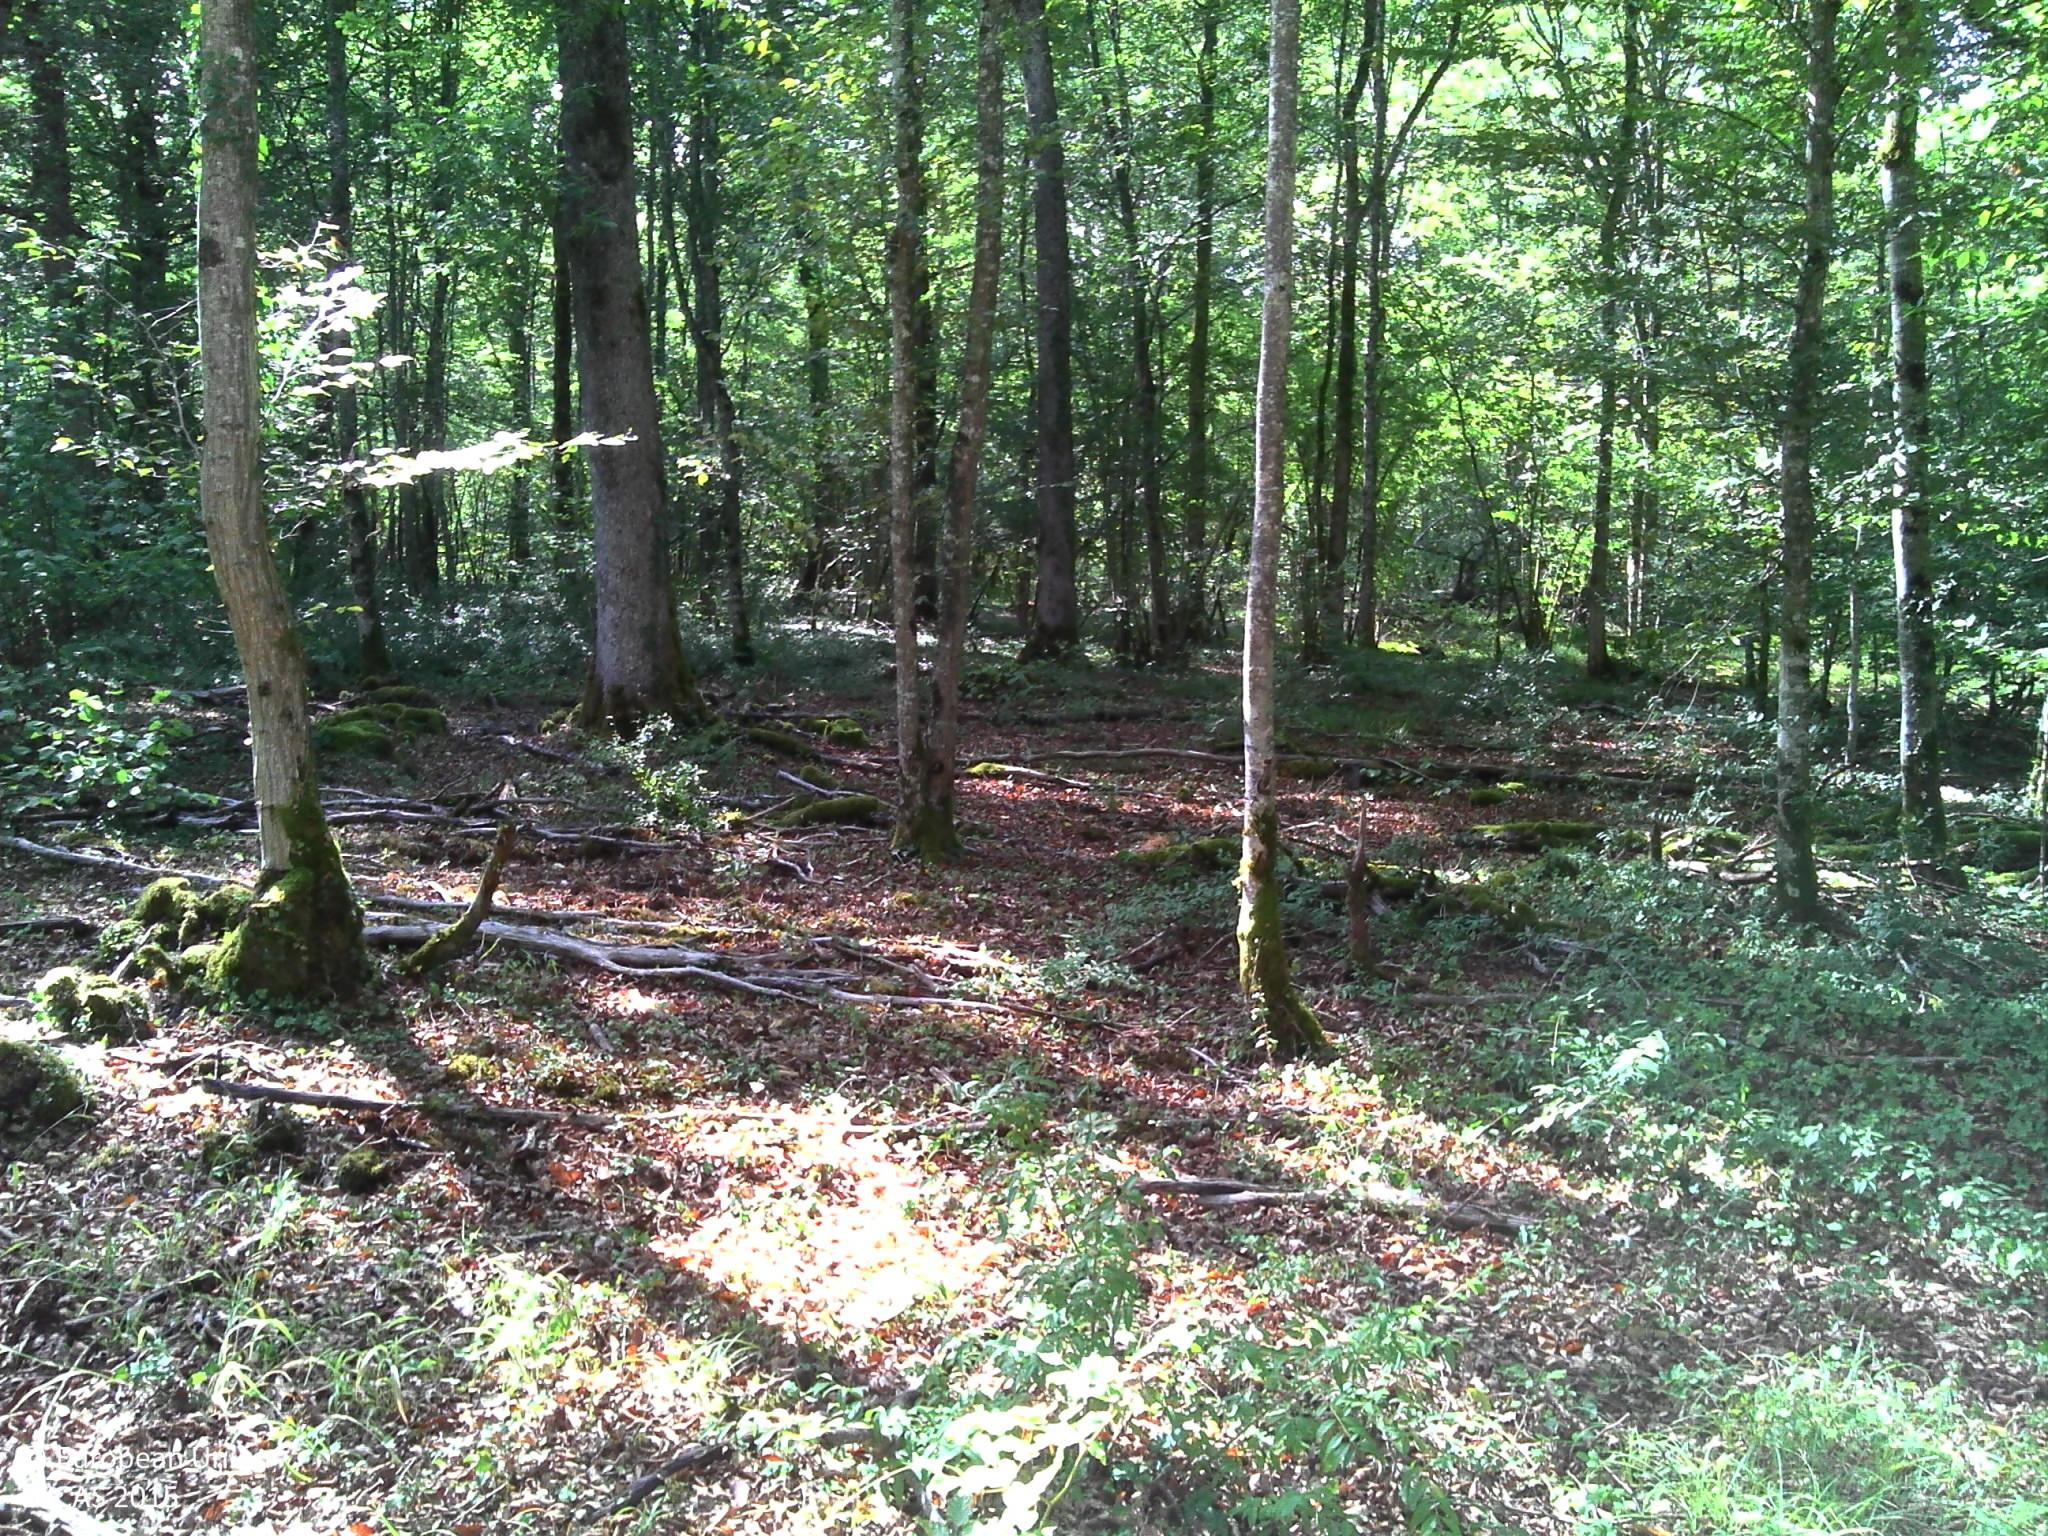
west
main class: Woodland
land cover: Broadleaved woodland
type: mesophytic deciduous forest
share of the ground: > 75 %
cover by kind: broadleaved forest trees 85 %, shrubs 5 %, herbaceous plants 5 %, lichens and mosses 5 %
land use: Forestry
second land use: Amenities, museums, leisure
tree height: > 5 m
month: August
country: FR
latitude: 47.8559
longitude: 4.9605
